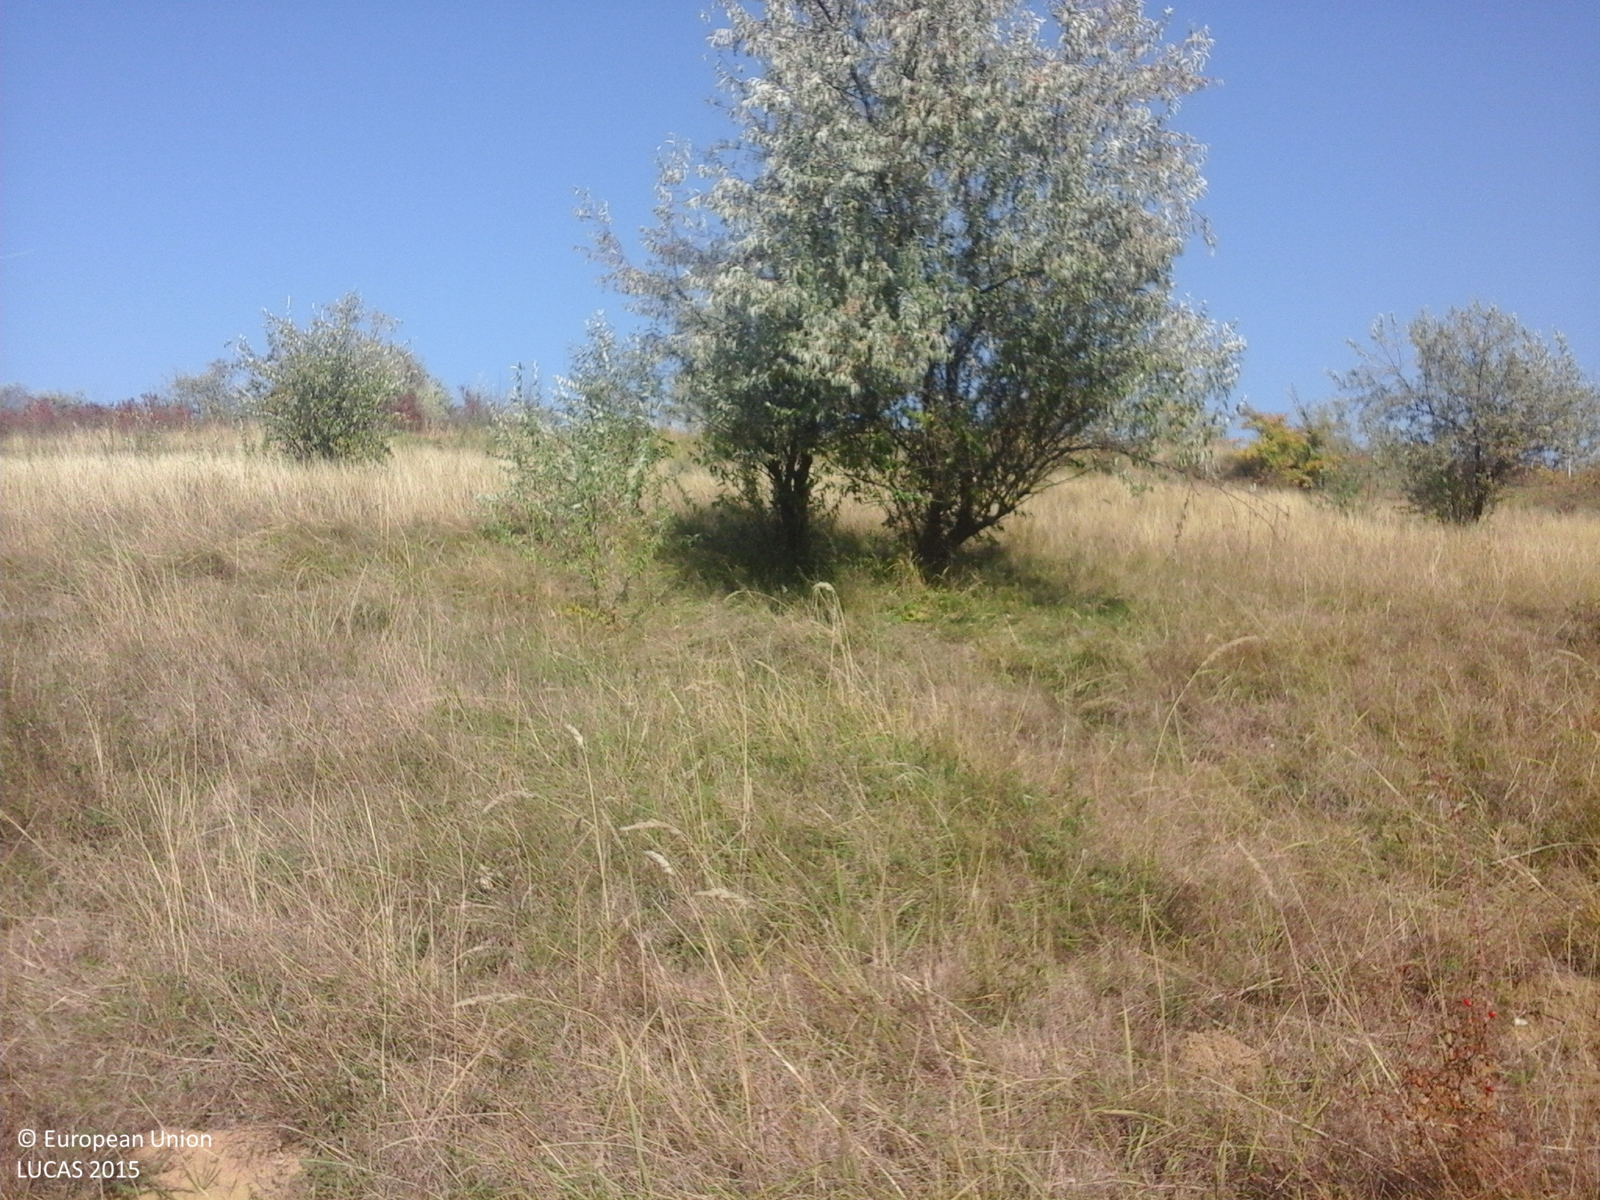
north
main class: Grassland
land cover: Grassland with sparse tree/shrub cover
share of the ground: > 75 %
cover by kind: herbaceous plants 85 %, shrubs 10 %, broadleaved forest trees 5 %
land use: Fallow land
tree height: < 5 m
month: October
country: RO
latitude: 45.0719
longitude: 26.4156
